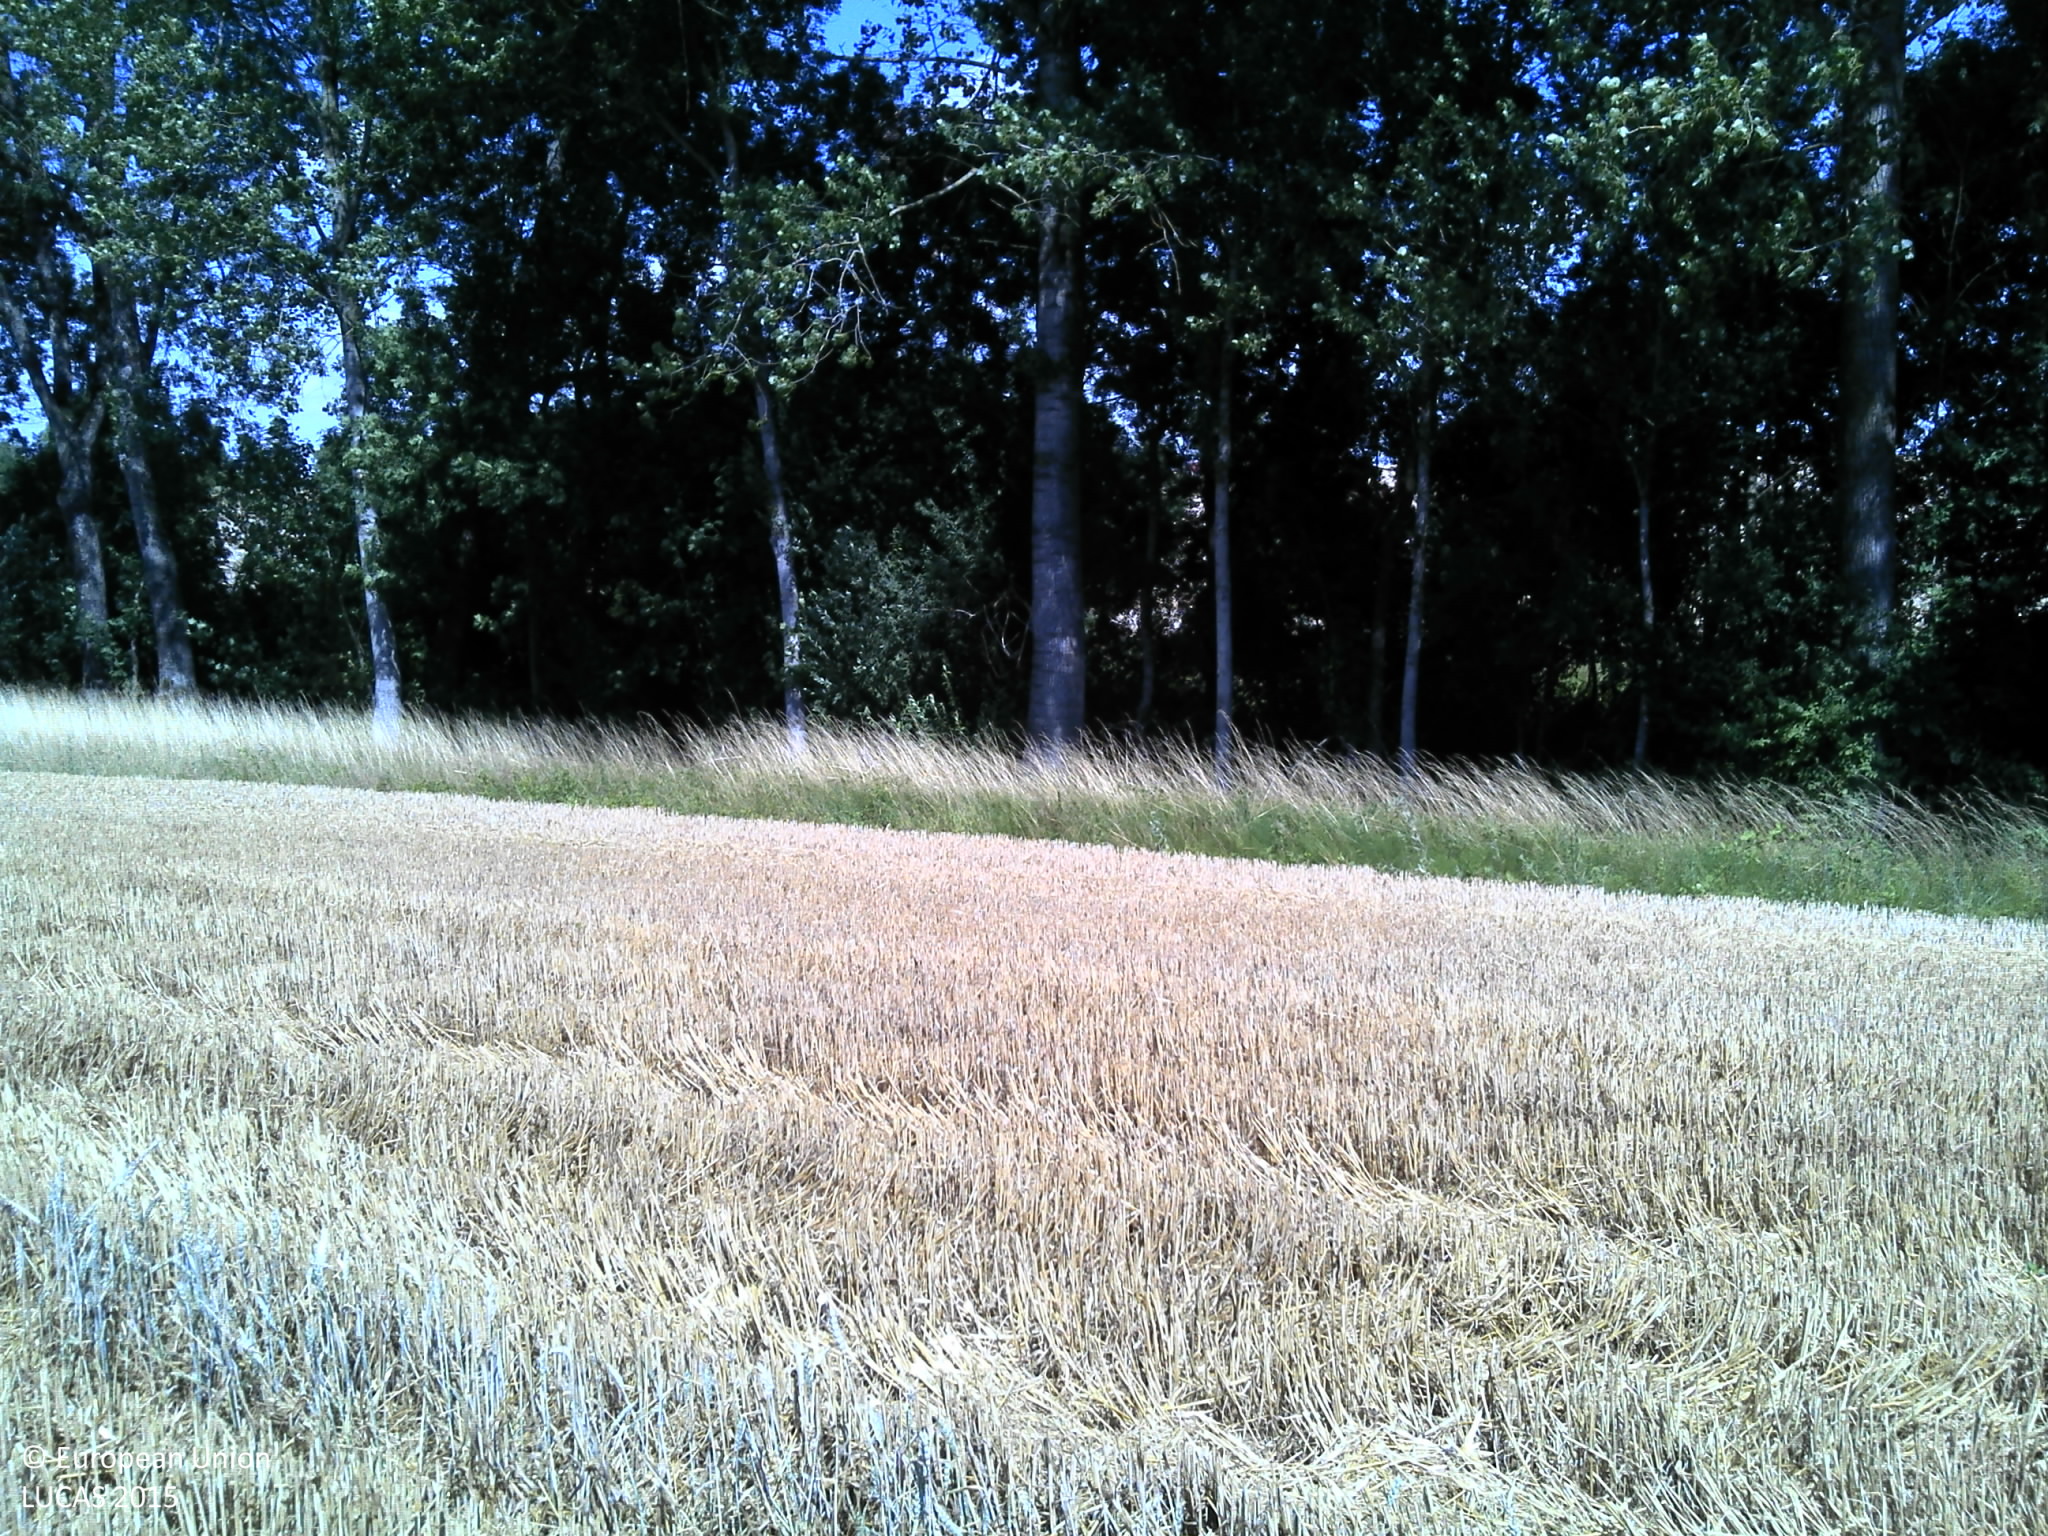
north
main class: Cropland
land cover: Common wheat
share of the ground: > 75 %
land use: Agriculture (excluding fallow land and kitchen gardens)
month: August
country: FR
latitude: 49.0338
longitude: 4.7037
